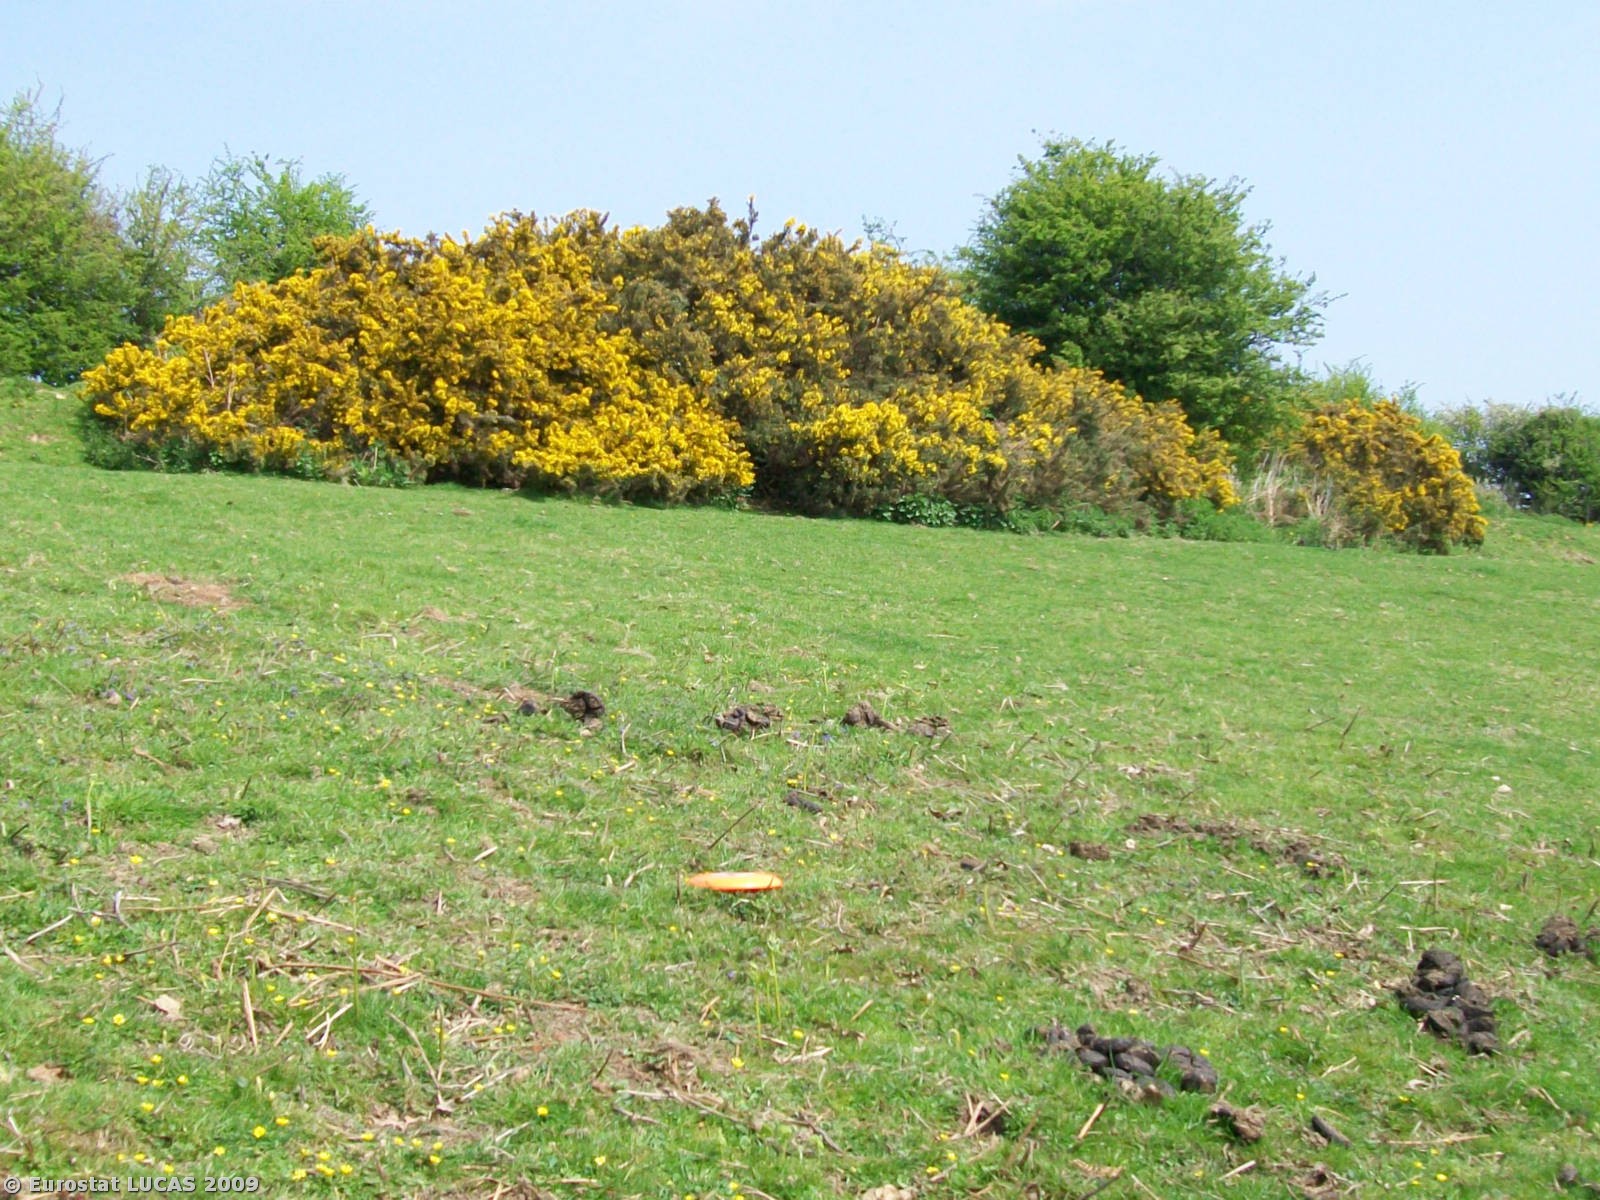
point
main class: Grassland
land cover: Grassland with sparse tree/shrub cover
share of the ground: > 75 %
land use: Agriculture (excluding fallow land and kitchen gardens)
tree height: < 5 m
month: April
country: GB
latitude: 50.8633
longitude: 0.3808
